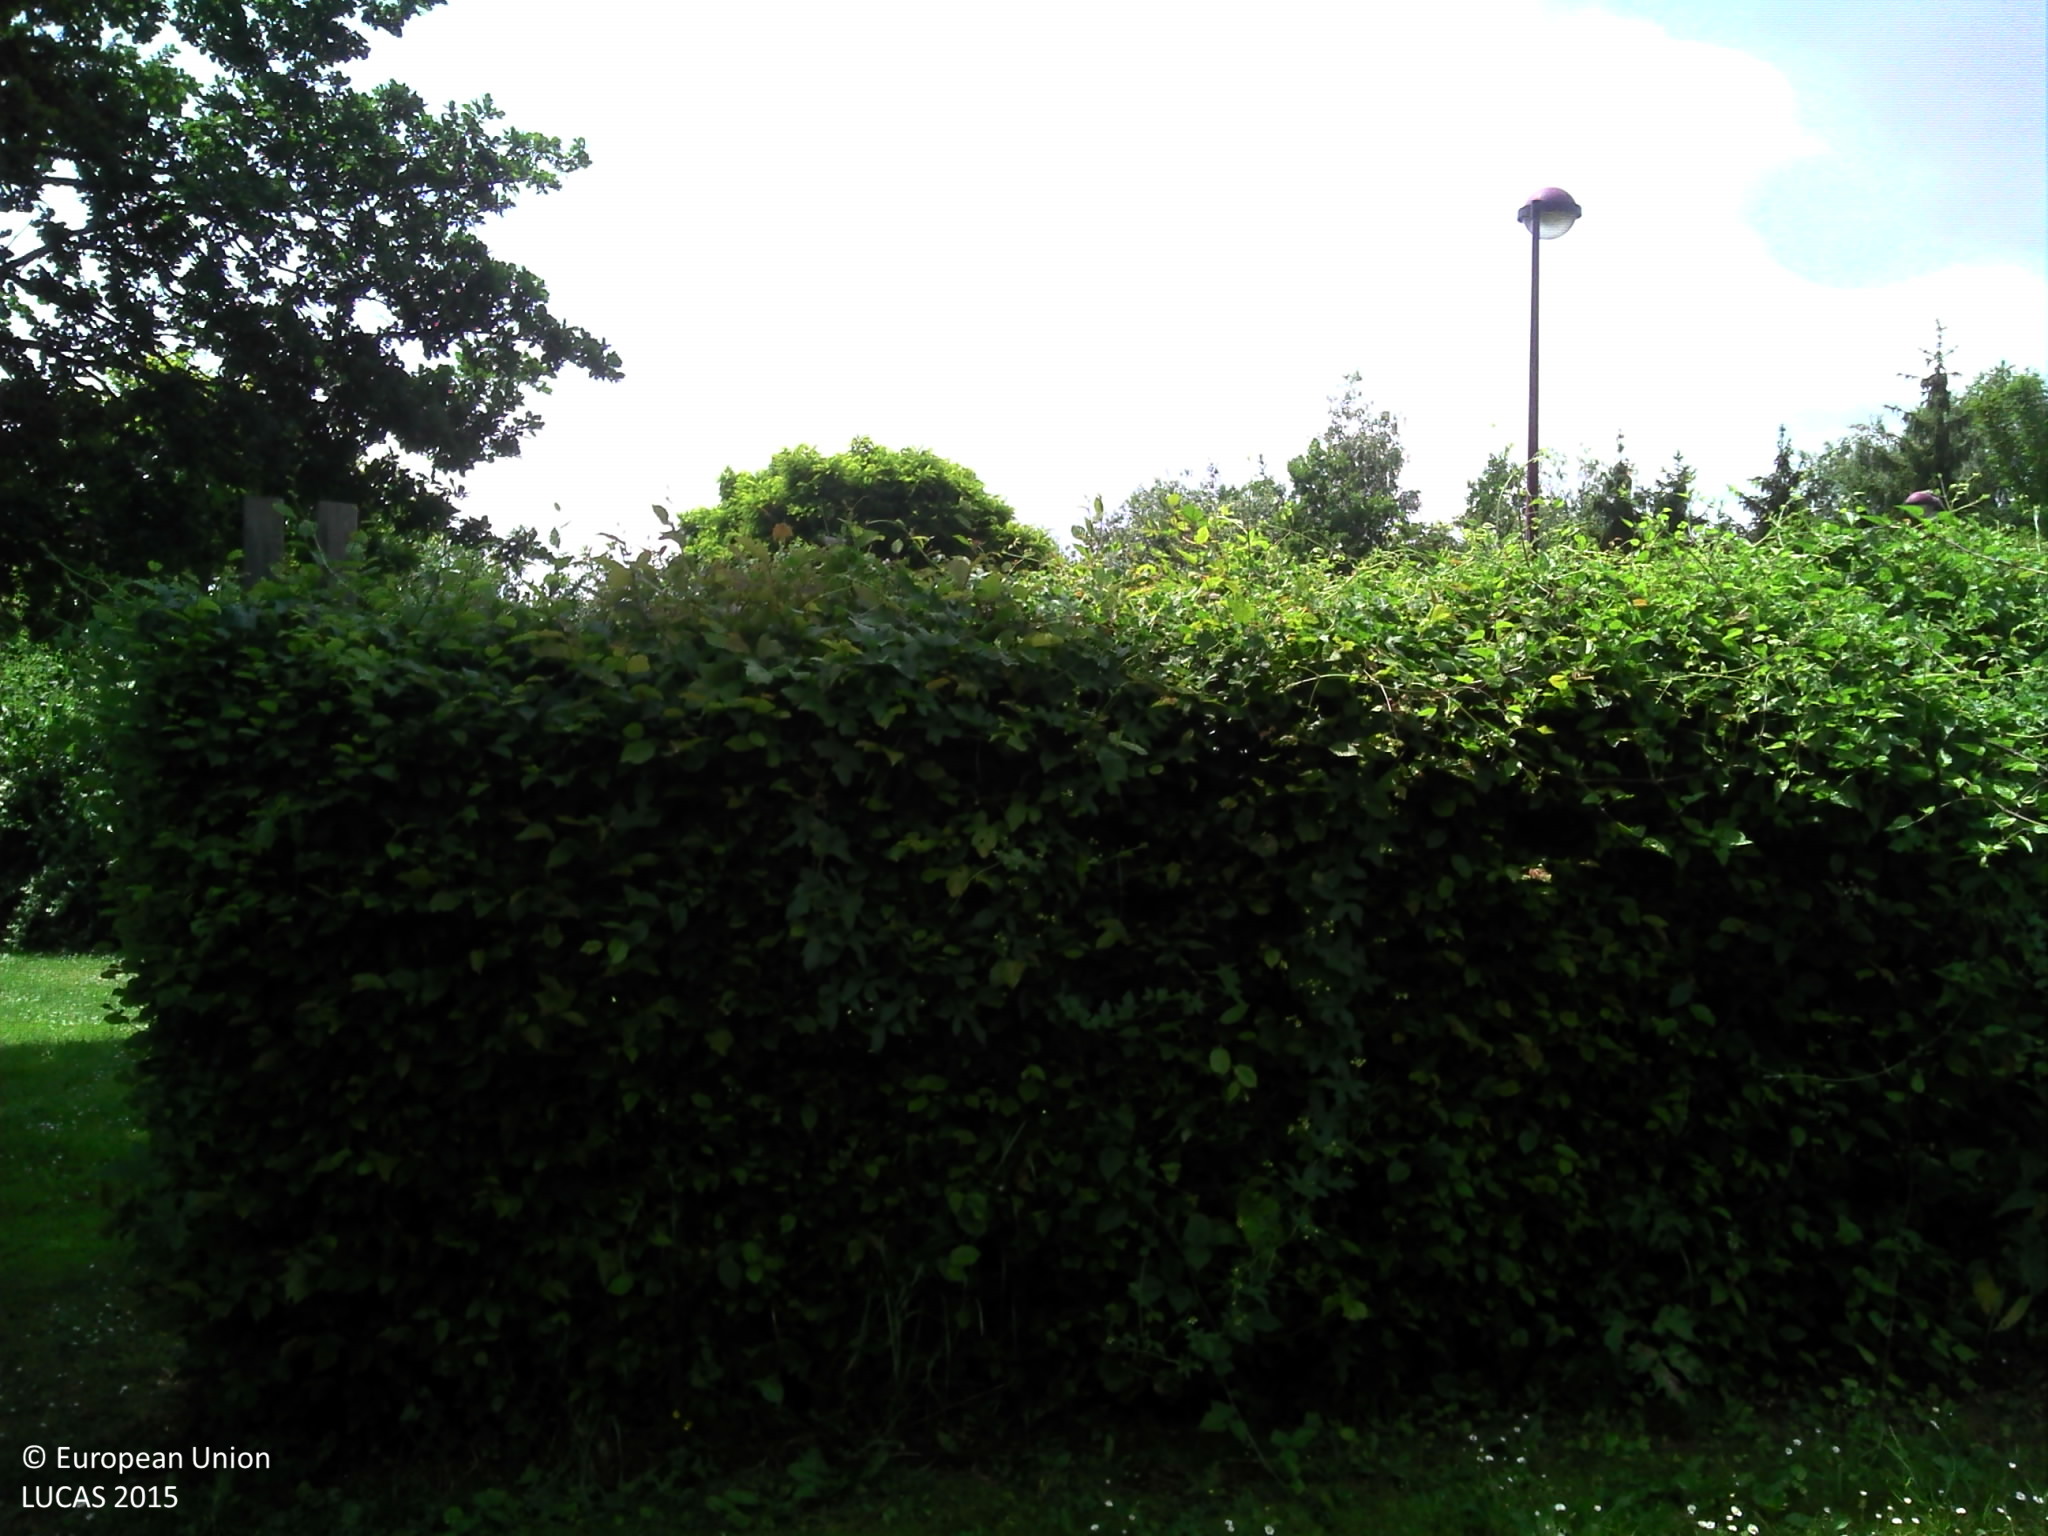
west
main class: Grassland
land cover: Grassland with sparse tree/shrub cover
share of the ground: > 75 %
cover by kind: herbaceous plants 85 %, shrubs 10 %, broadleaved forest trees 5 %
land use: Sport
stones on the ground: < 10 %
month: June
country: BE
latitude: 50.4837
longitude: 4.8809
